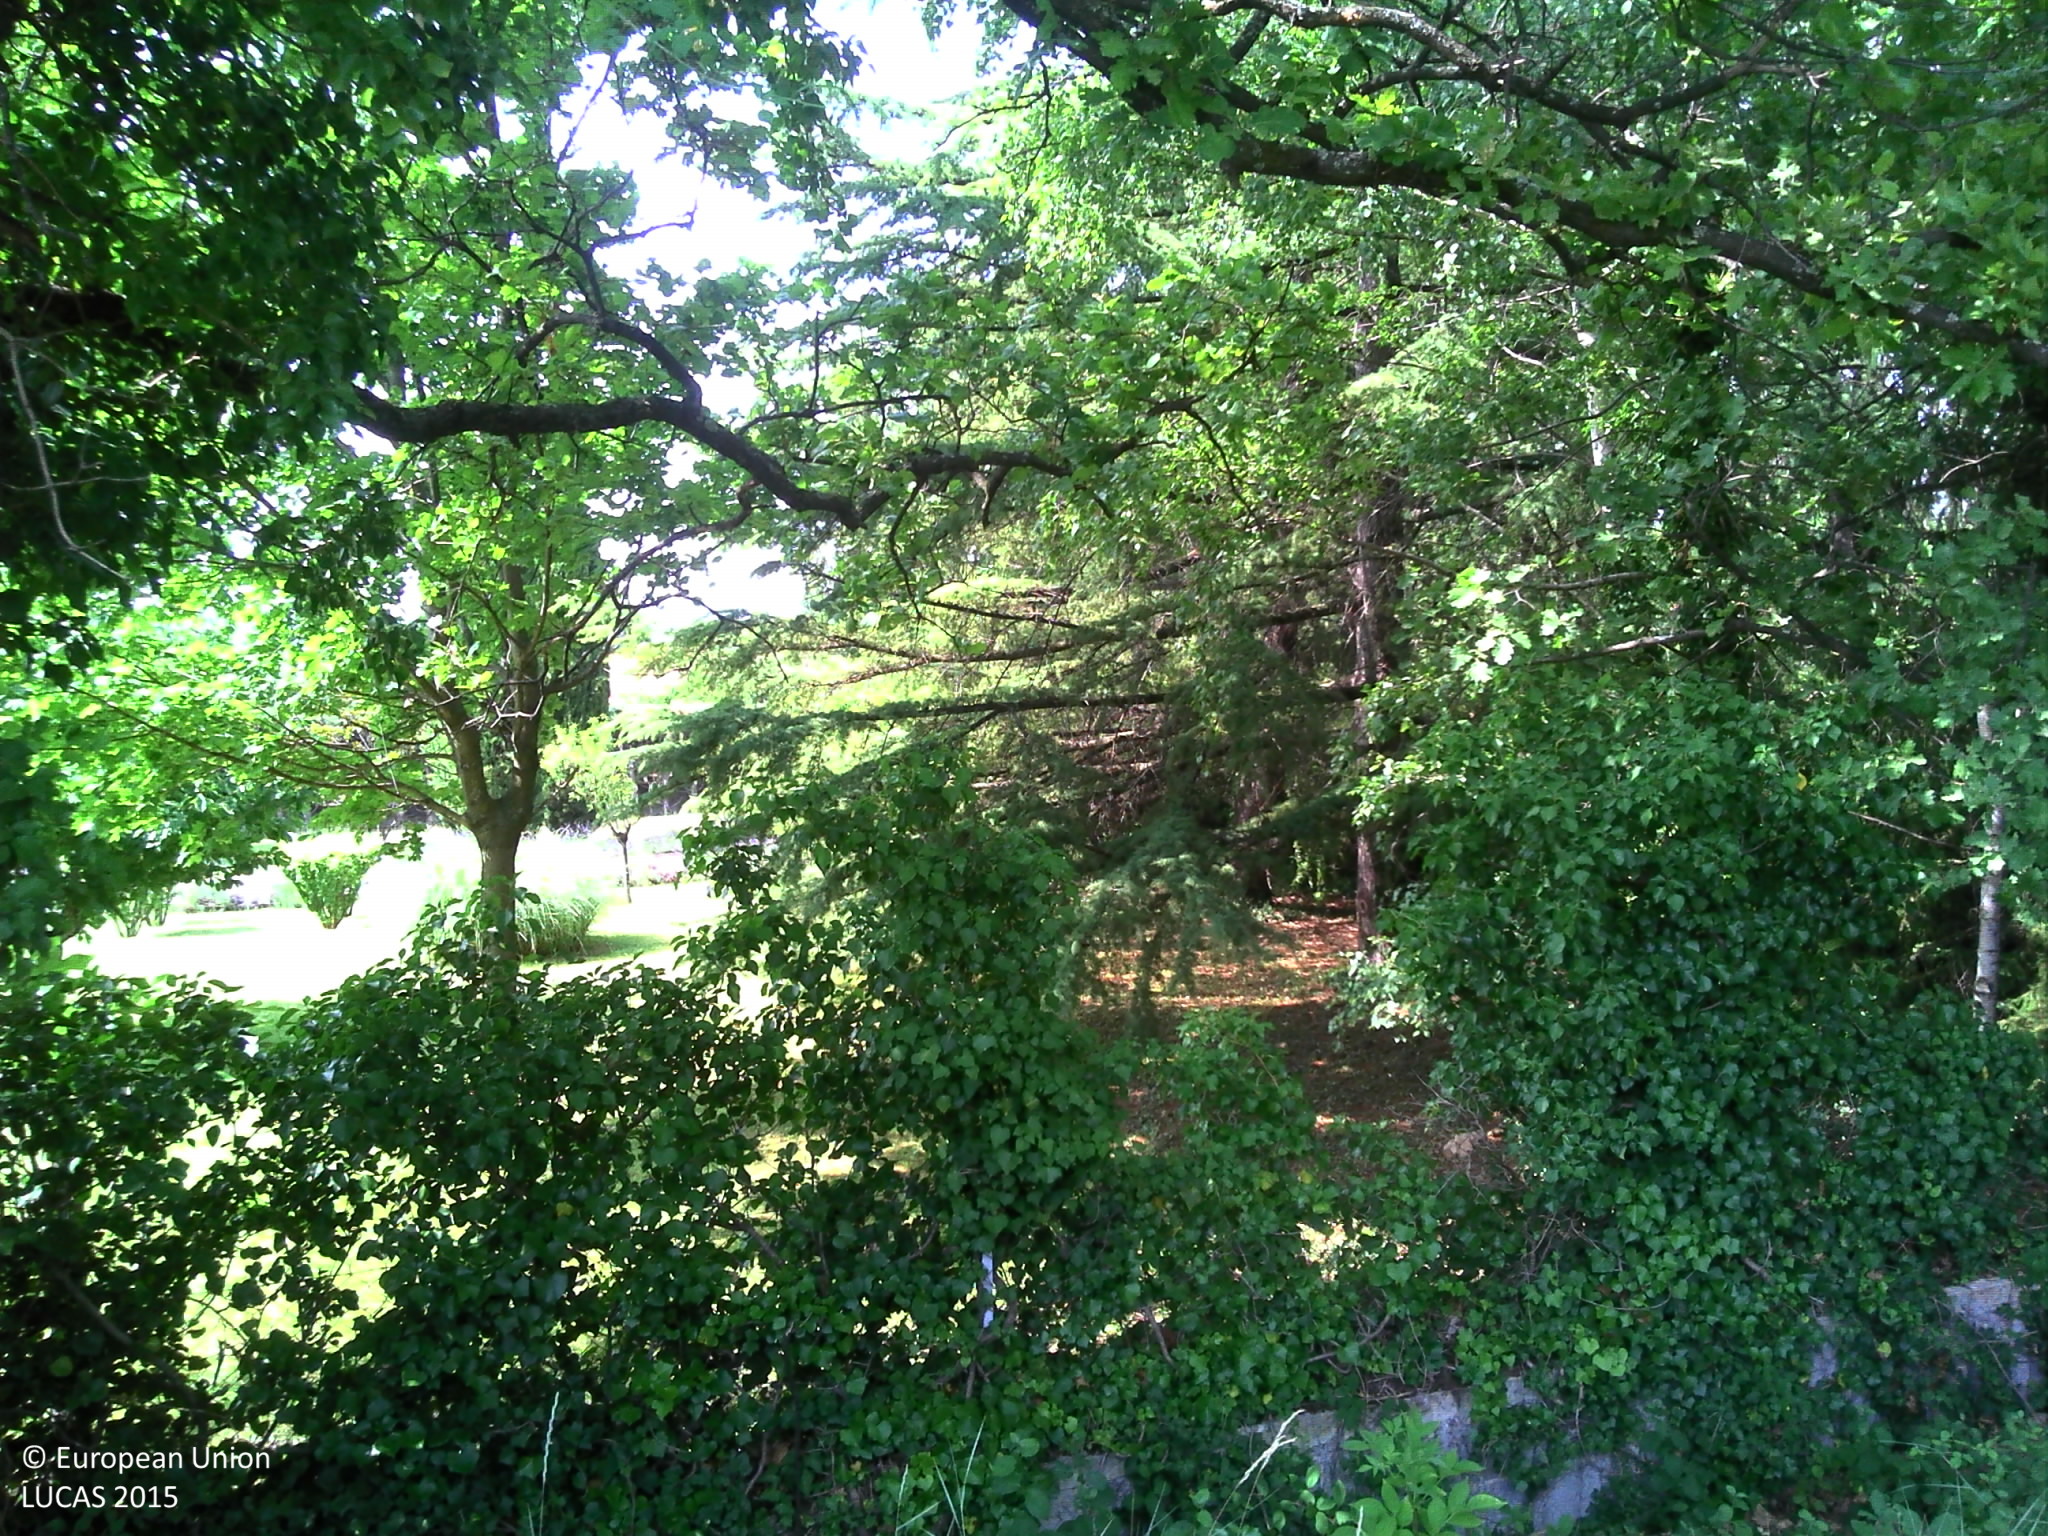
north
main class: Grassland
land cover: Spontaneously vegetated surfaces
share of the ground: > 75 %
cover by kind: herbaceous plants 100 %
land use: Semi-natural and natural areas not in use
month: July
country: FR
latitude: 44.3746
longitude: 4.9998
